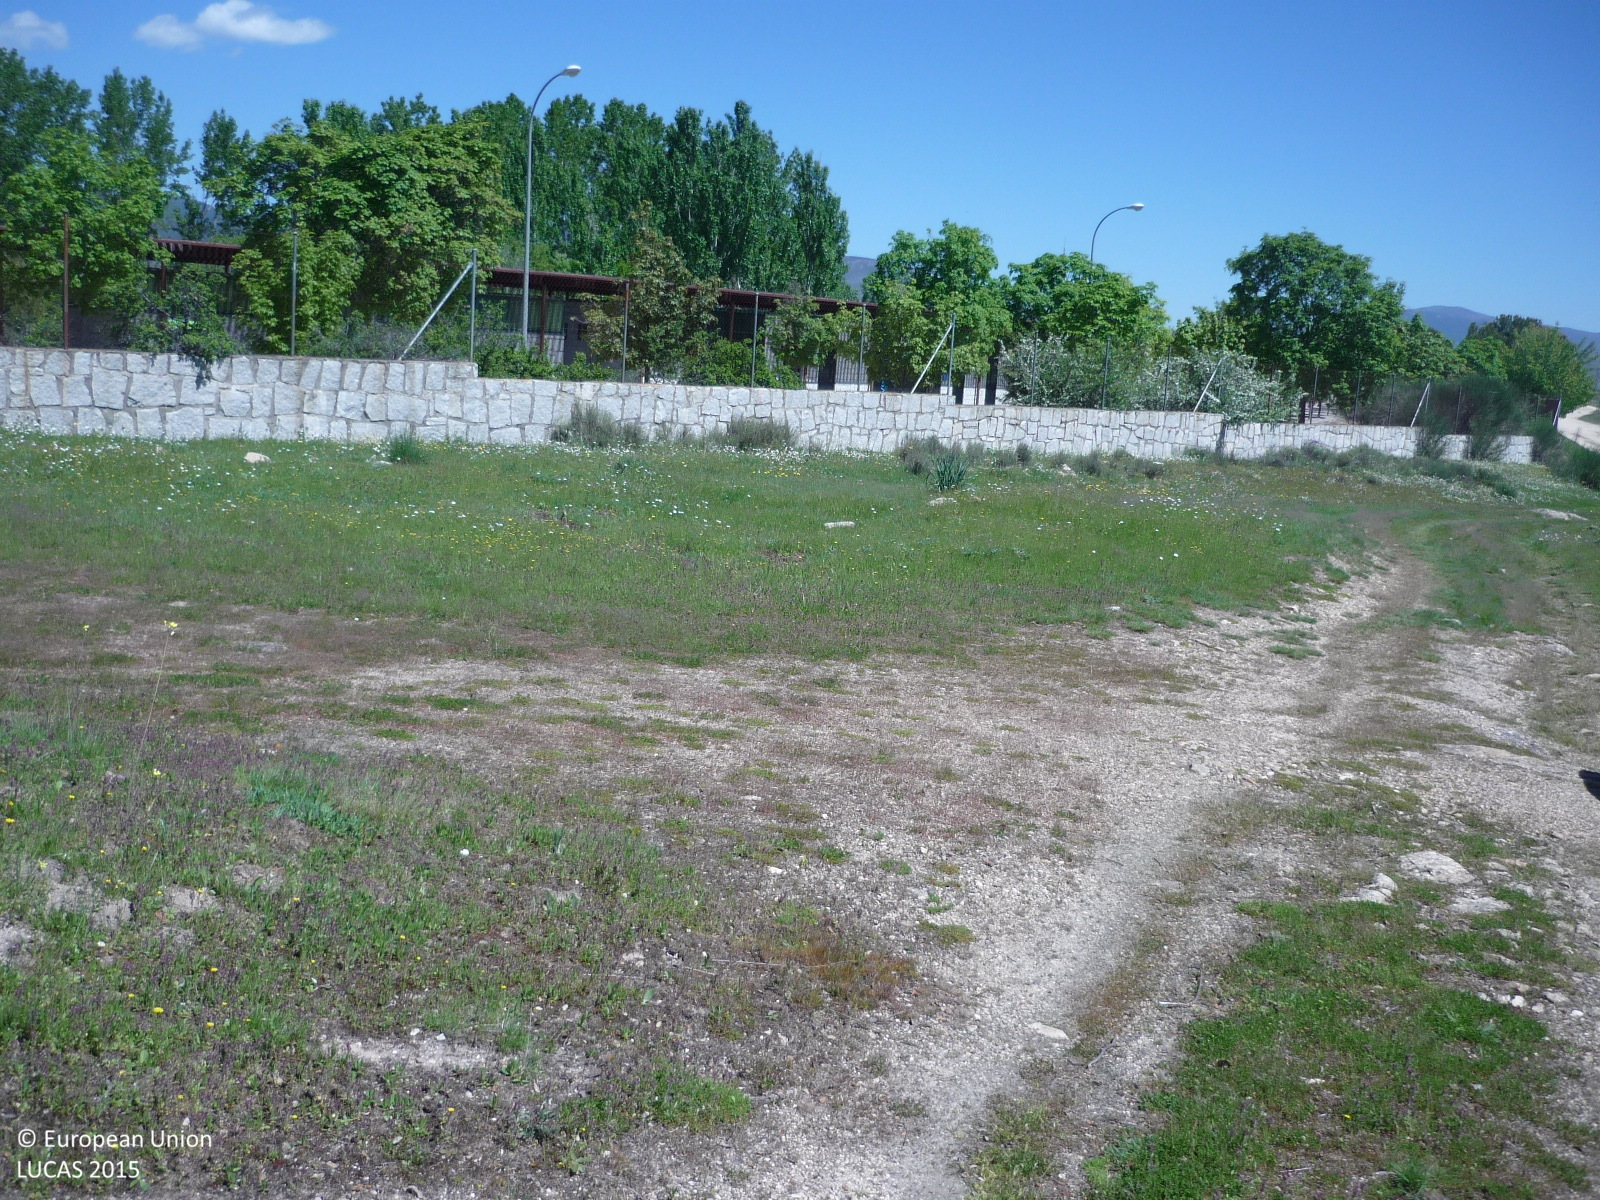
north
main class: Woodland
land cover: Broadleaved woodland
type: broadleaved evergreen forest
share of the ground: > 75 %
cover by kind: broadleaved forest trees 85 %, shrubs 10 %, herbaceous plants 5 %
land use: Forestry
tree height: < 5 m
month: May
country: ES
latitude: 40.9747
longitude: -3.6510
